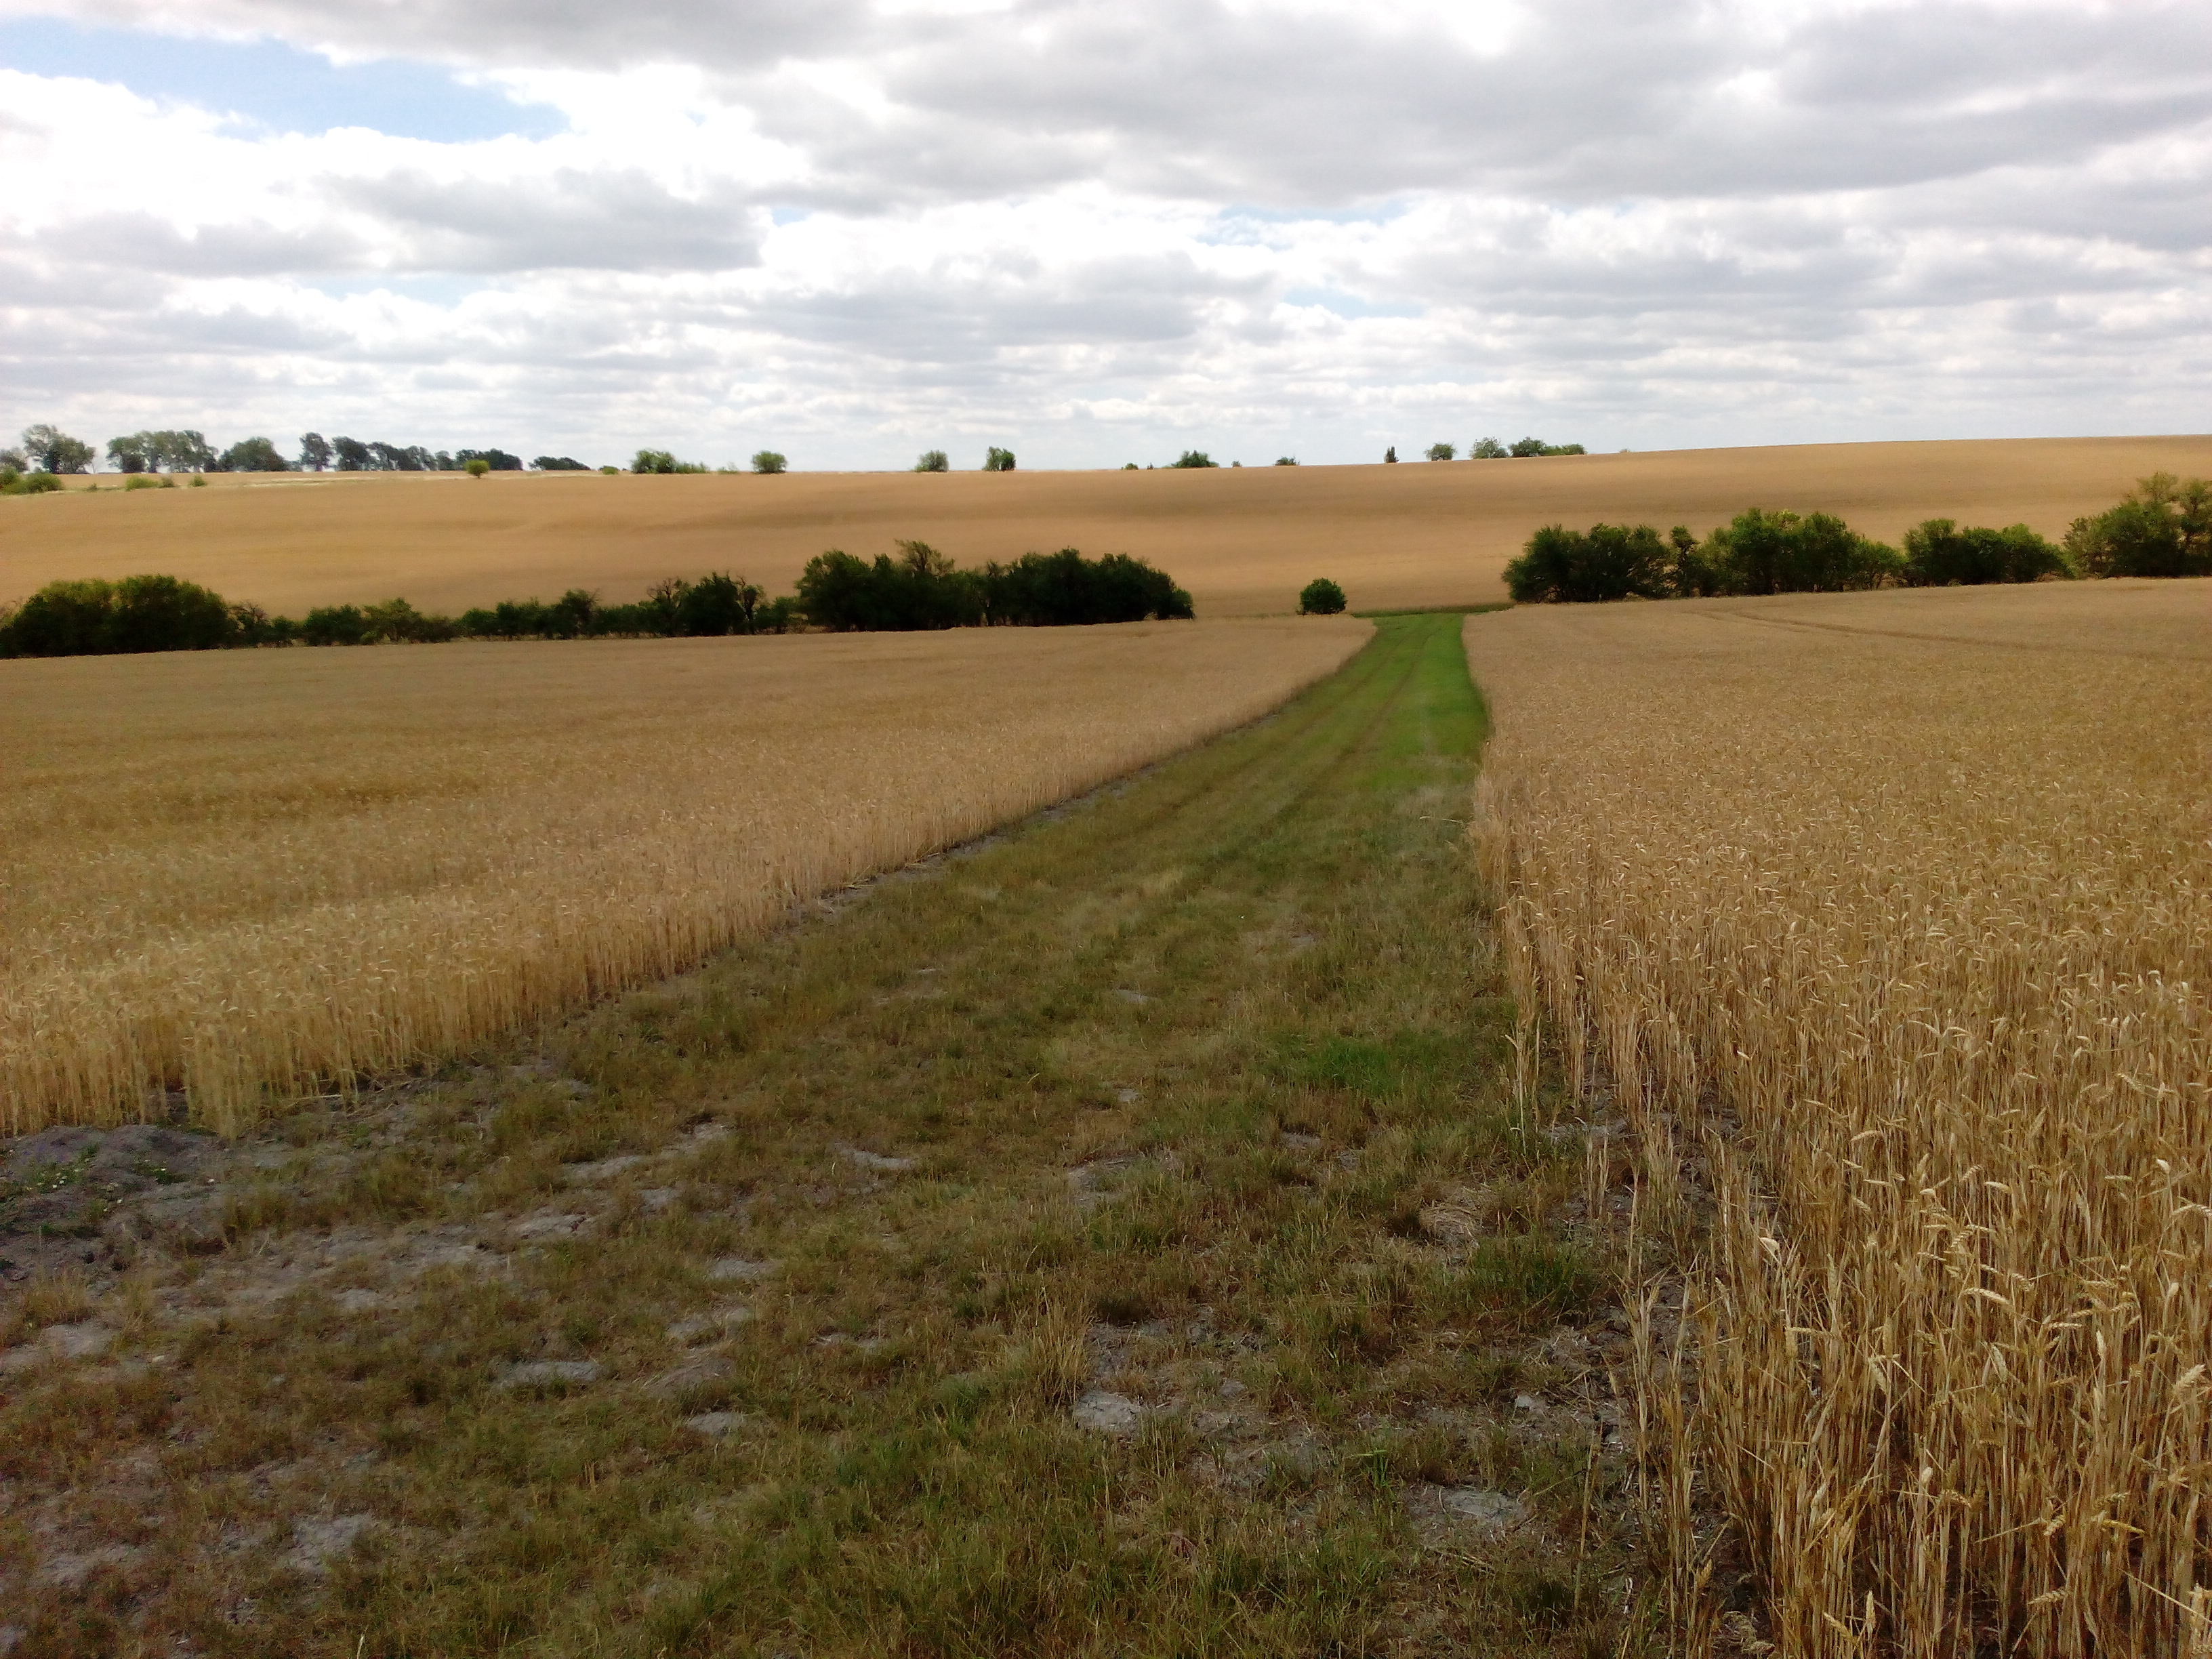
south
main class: Cropland
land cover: Common wheat
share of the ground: > 75 %
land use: Agriculture (excluding fallow land and kitchen gardens)
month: July
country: DE
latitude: 51.1694
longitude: 10.9294
